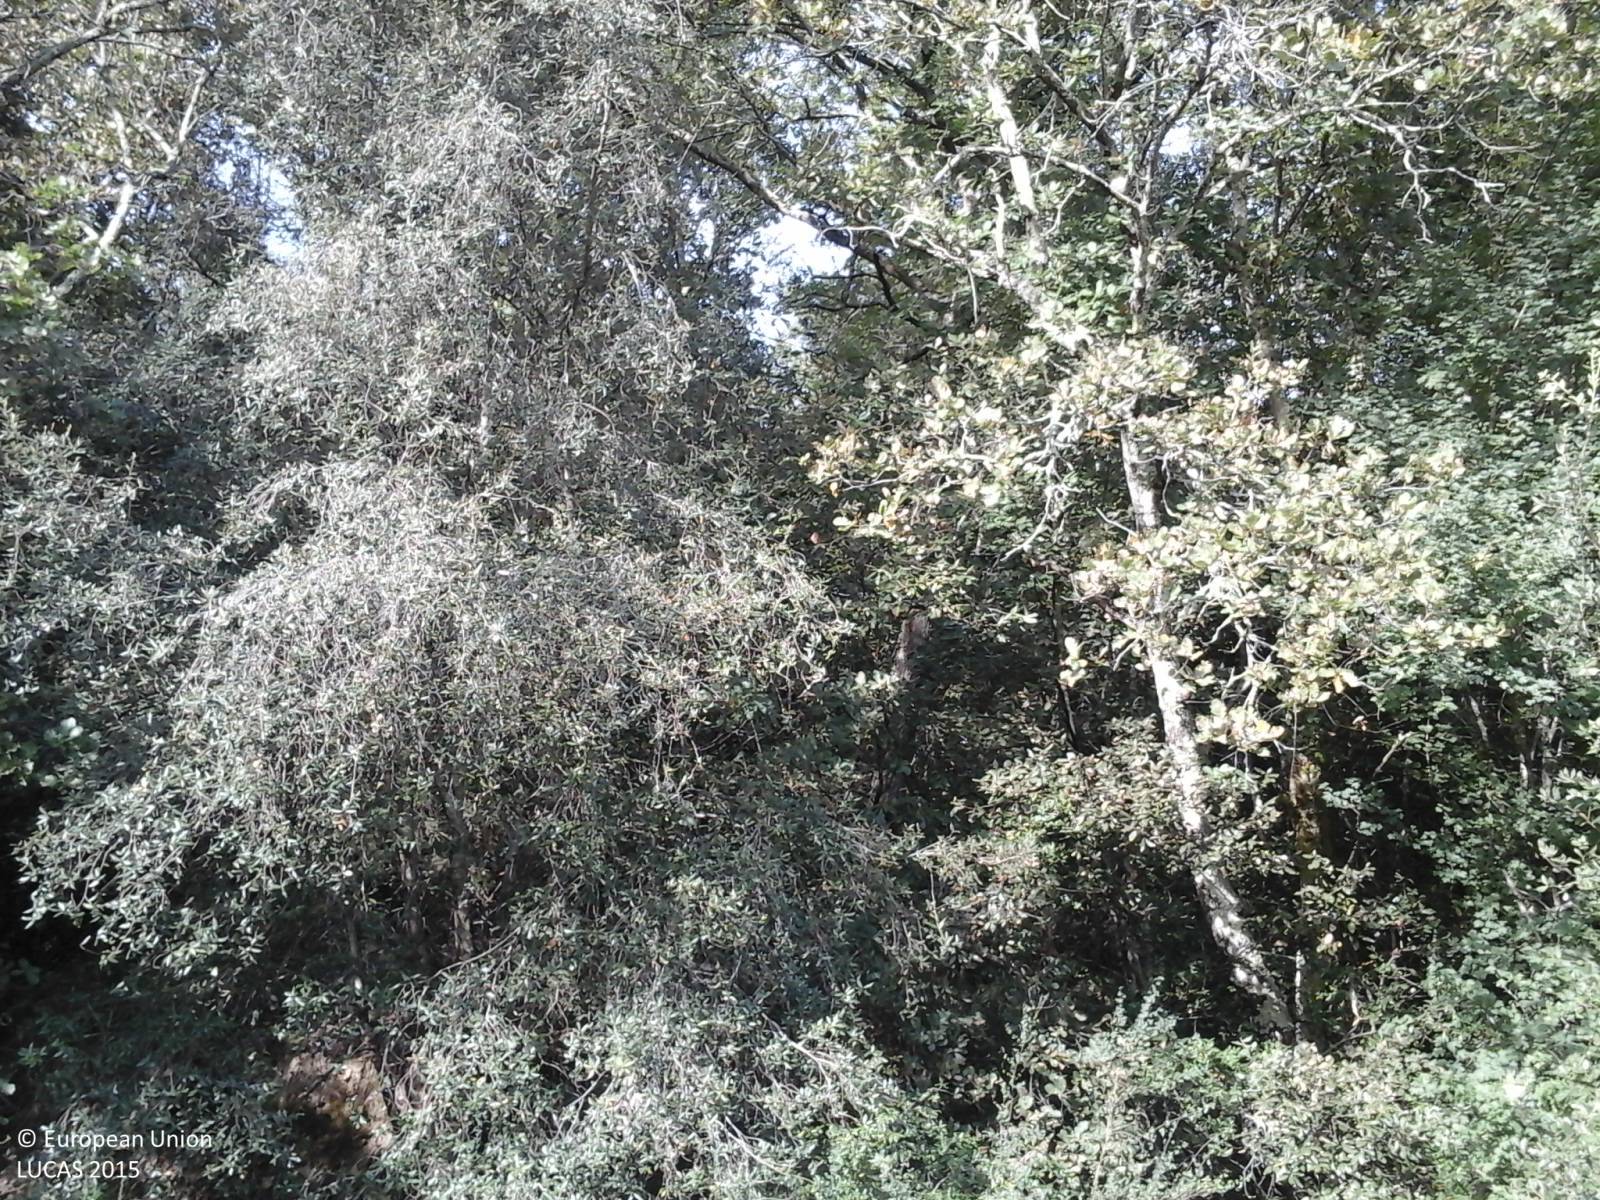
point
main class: Woodland
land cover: Broadleaved woodland
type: thermophilous deciduous forest
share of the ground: > 75 %
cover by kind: broadleaved forest trees 85 %, shrubs 15 %
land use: Forestry
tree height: > 5 m
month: September
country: IT
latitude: 42.7766
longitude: 12.1078
